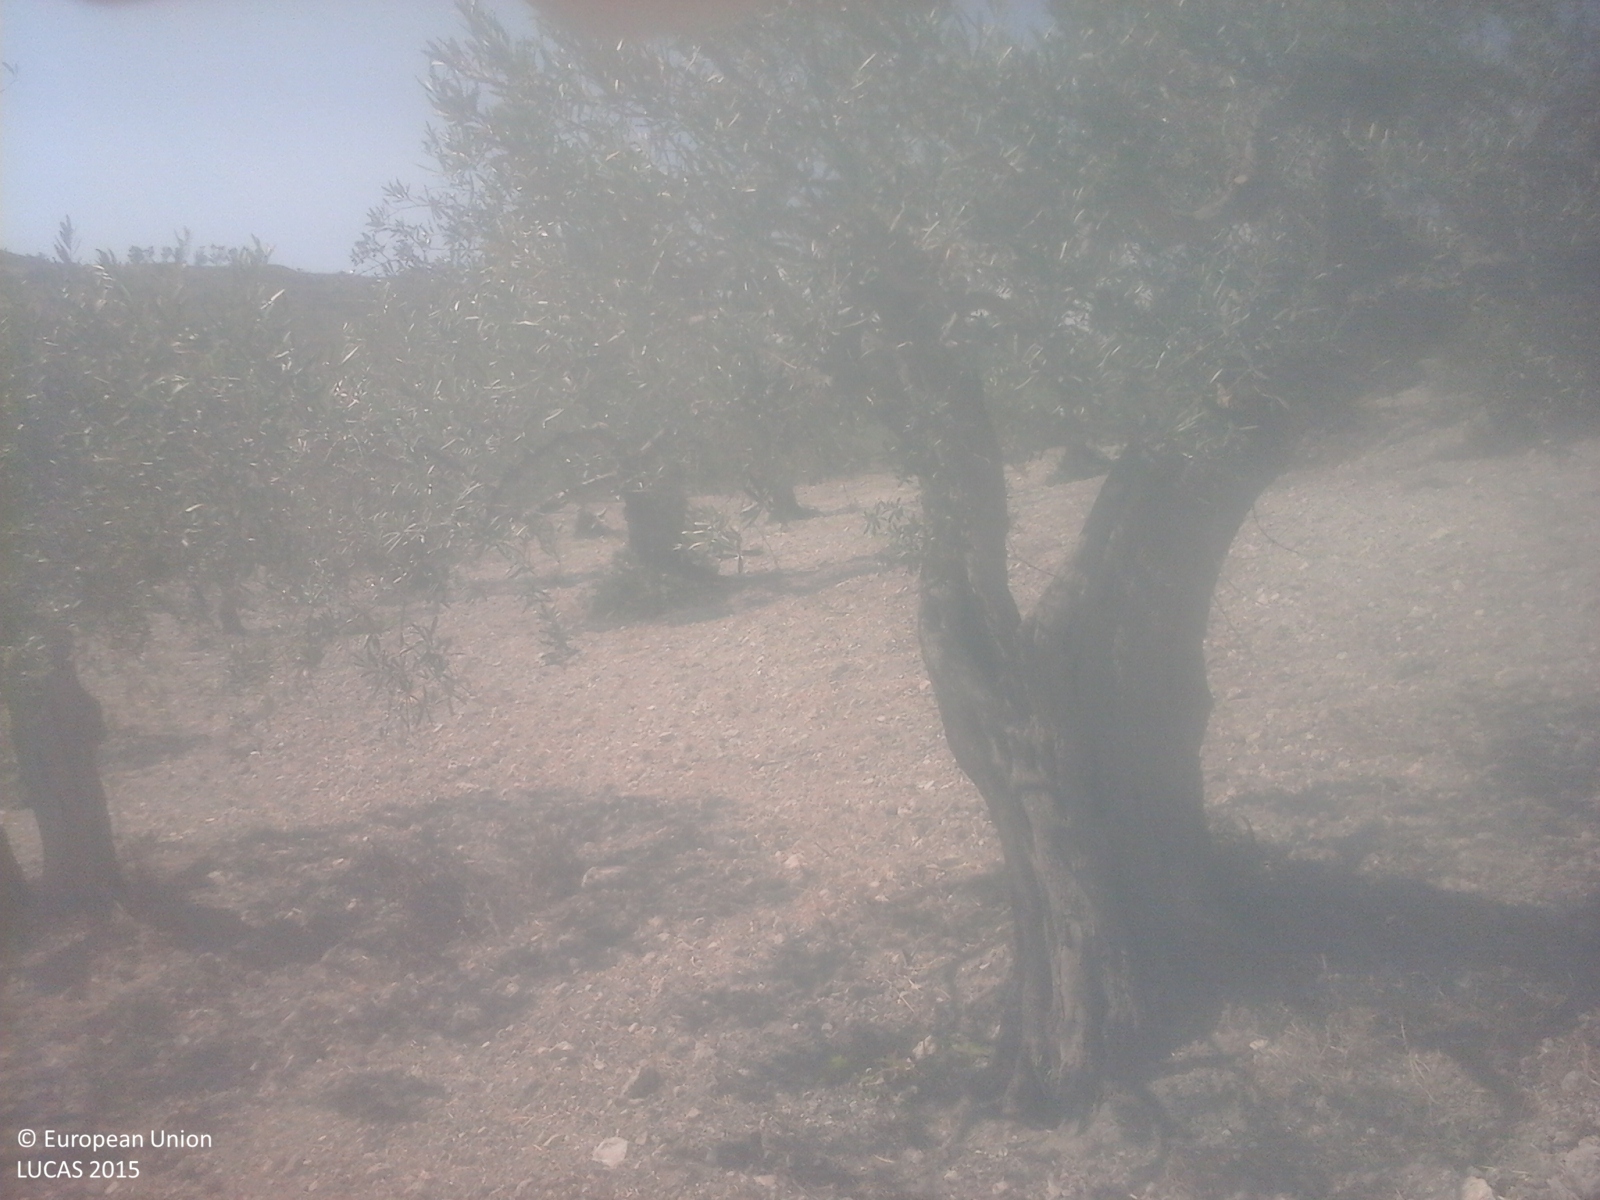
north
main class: Cropland
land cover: Olive groves
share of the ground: 25 - 50 %
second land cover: Other bare soil
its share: > 75 %
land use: Agriculture (excluding fallow land and kitchen gardens)
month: July
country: IT
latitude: 37.5657
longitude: 13.2248
